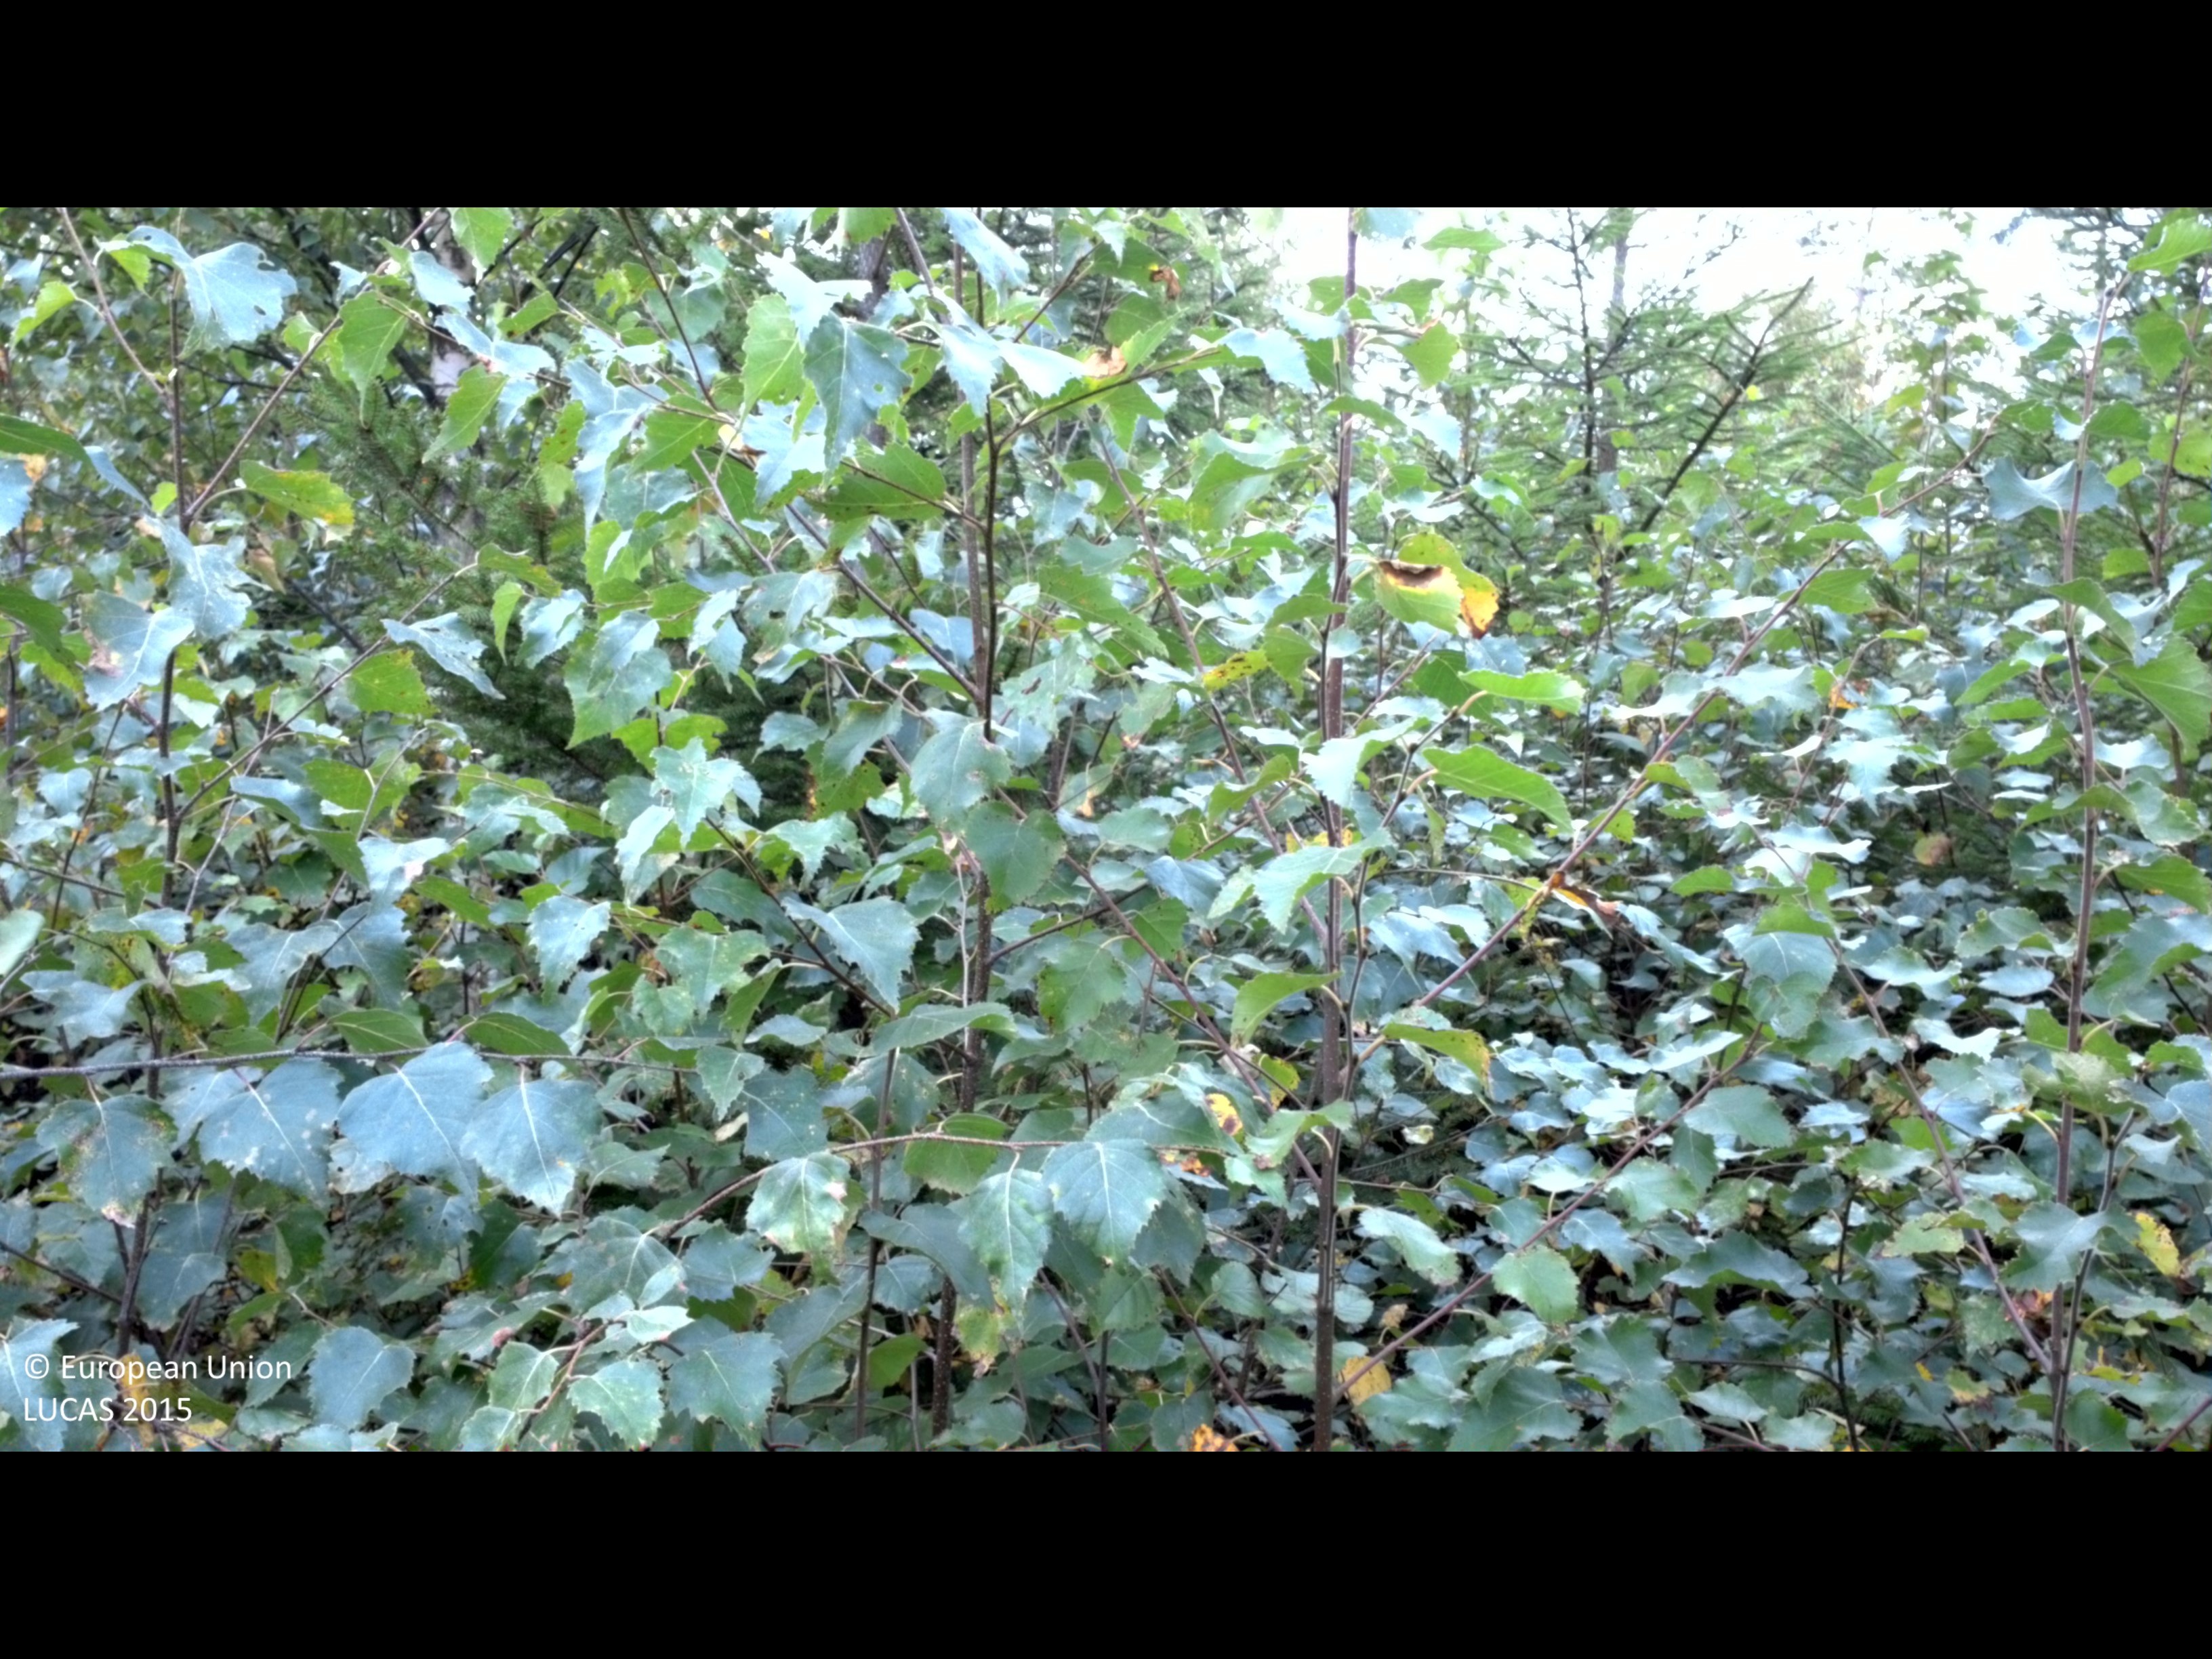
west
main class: Woodland
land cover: Spruce dominated mixed woodland
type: boreal forest
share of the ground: > 75 %
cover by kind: broadleaved forest trees 55 %, coniferous forest trees 35 %, shrubs 5 %, herbaceous plants 5 %
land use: Forestry
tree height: < 5 m
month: September
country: SE
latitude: 56.7616
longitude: 13.1211
